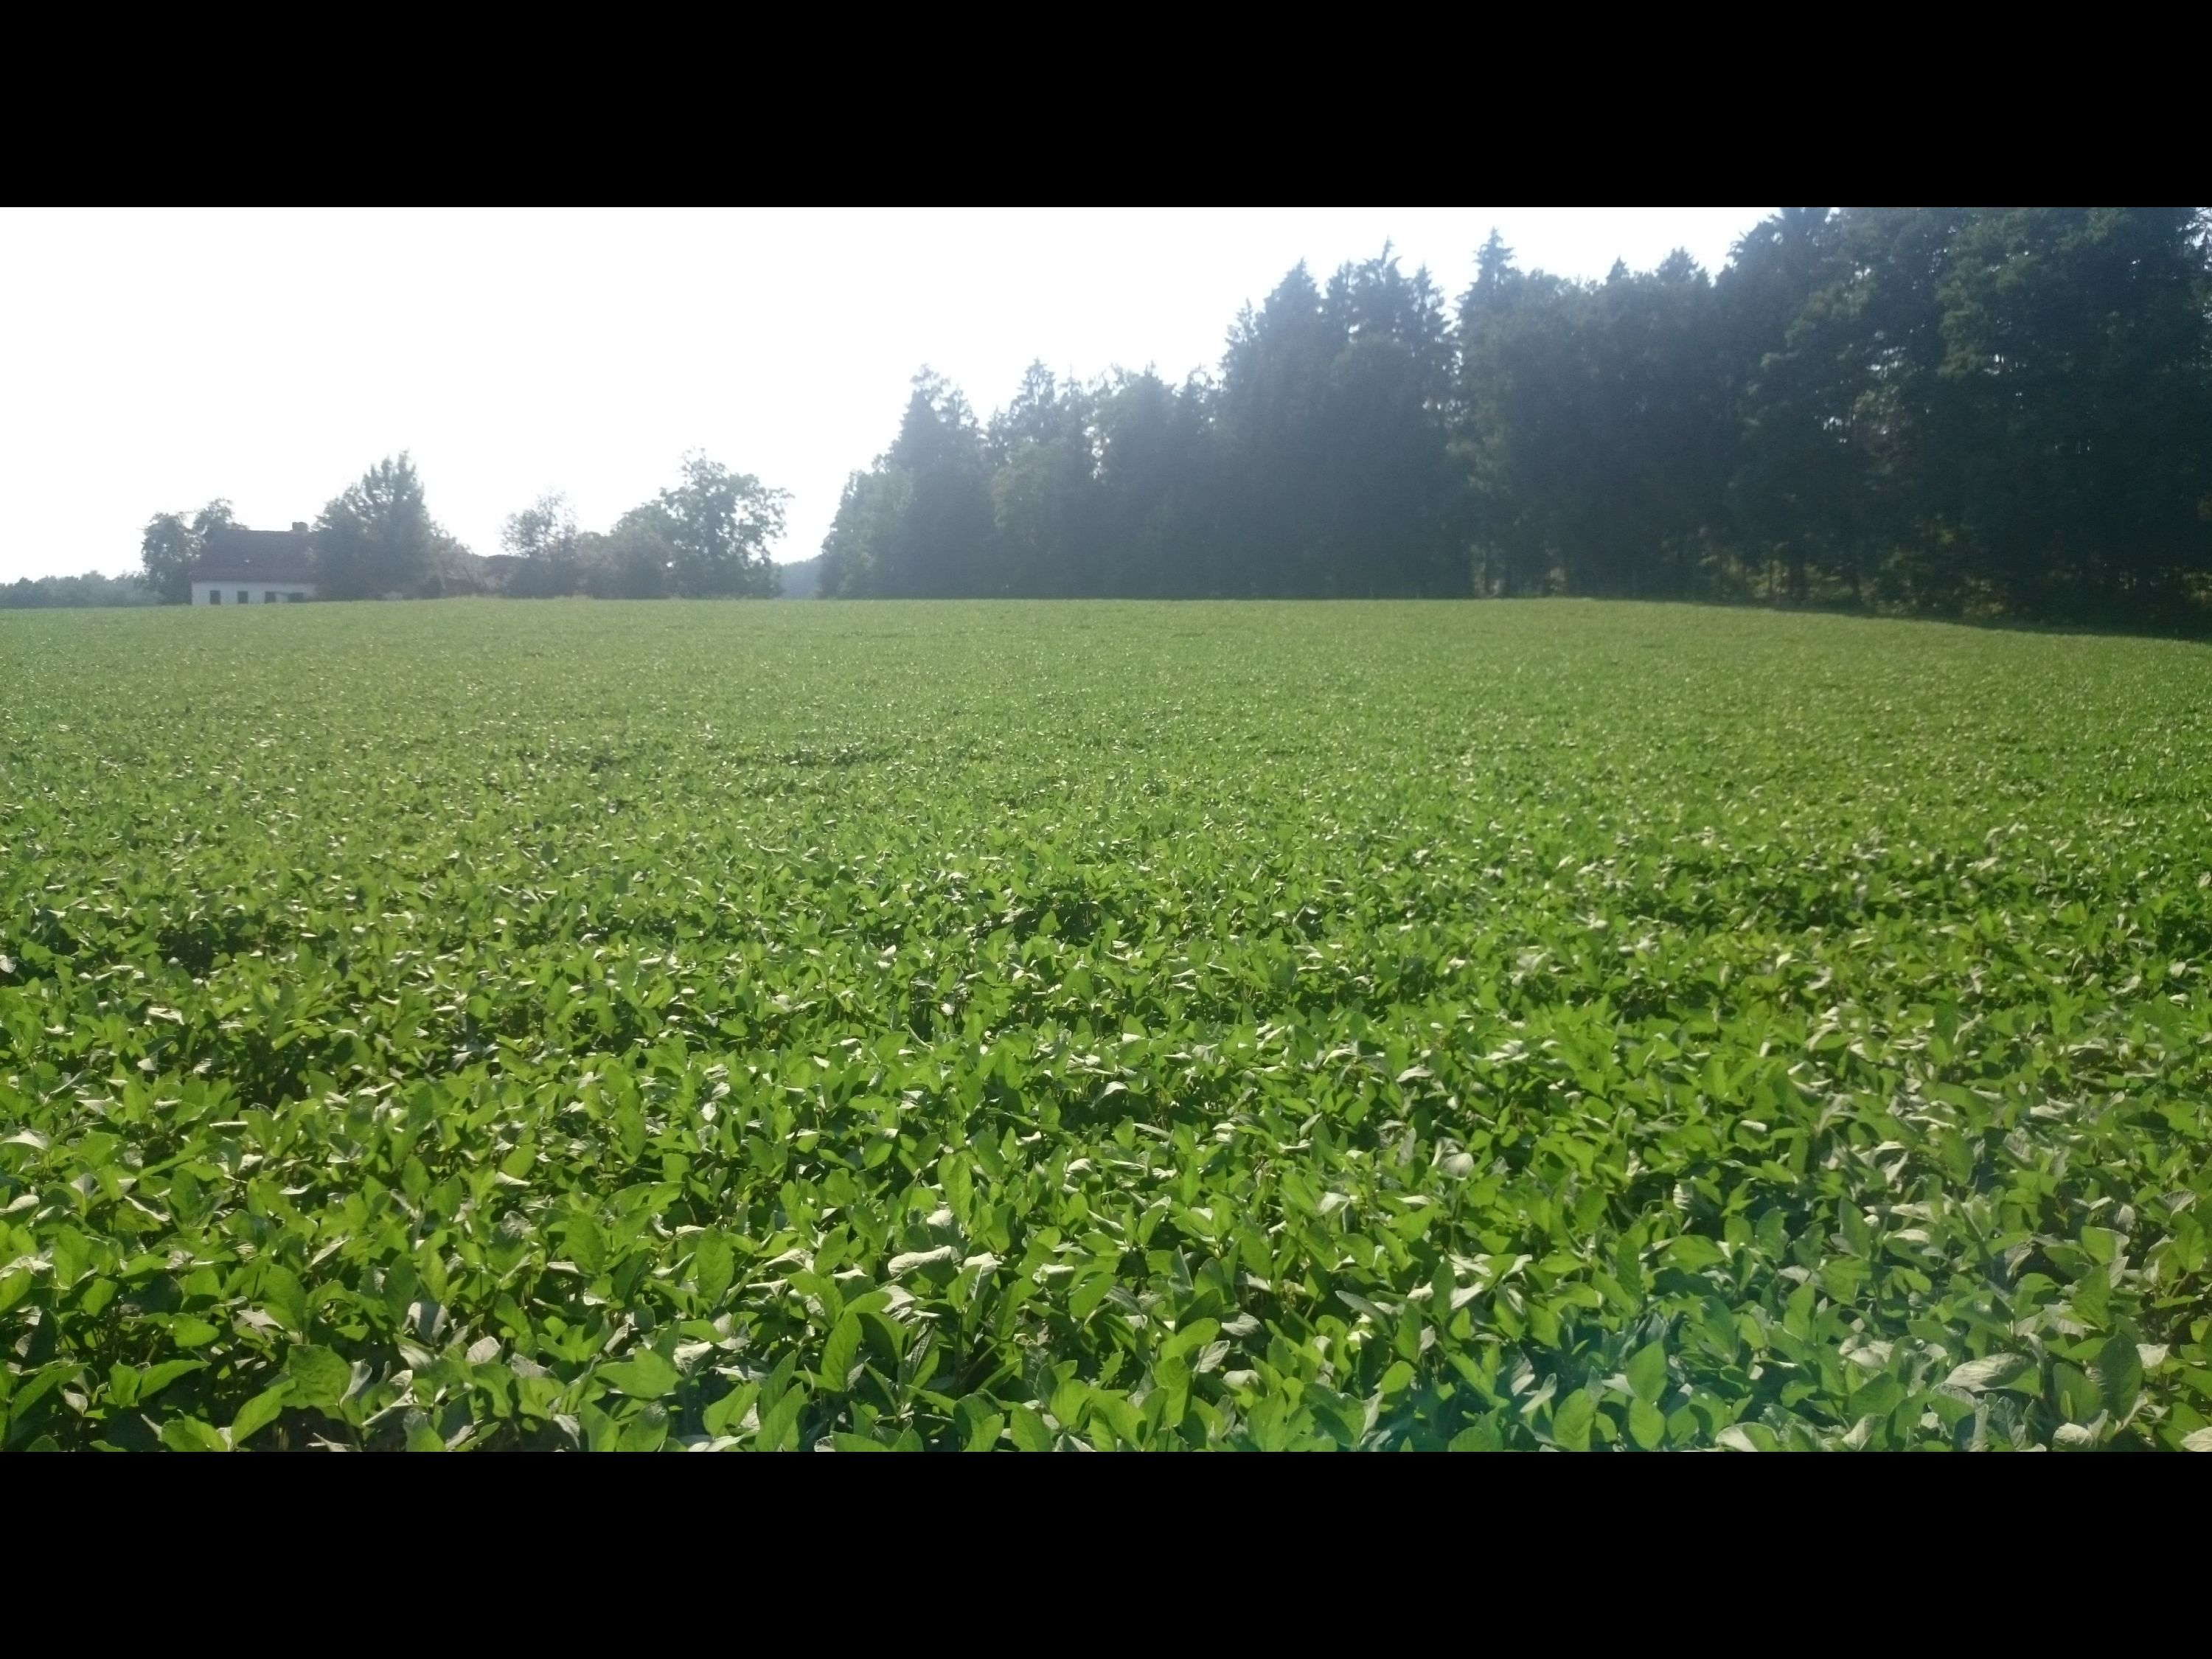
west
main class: Cropland
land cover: Soya
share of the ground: > 75 %
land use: Agriculture (excluding fallow land and kitchen gardens)
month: July
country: AT
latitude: 47.0514
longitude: 15.9642
